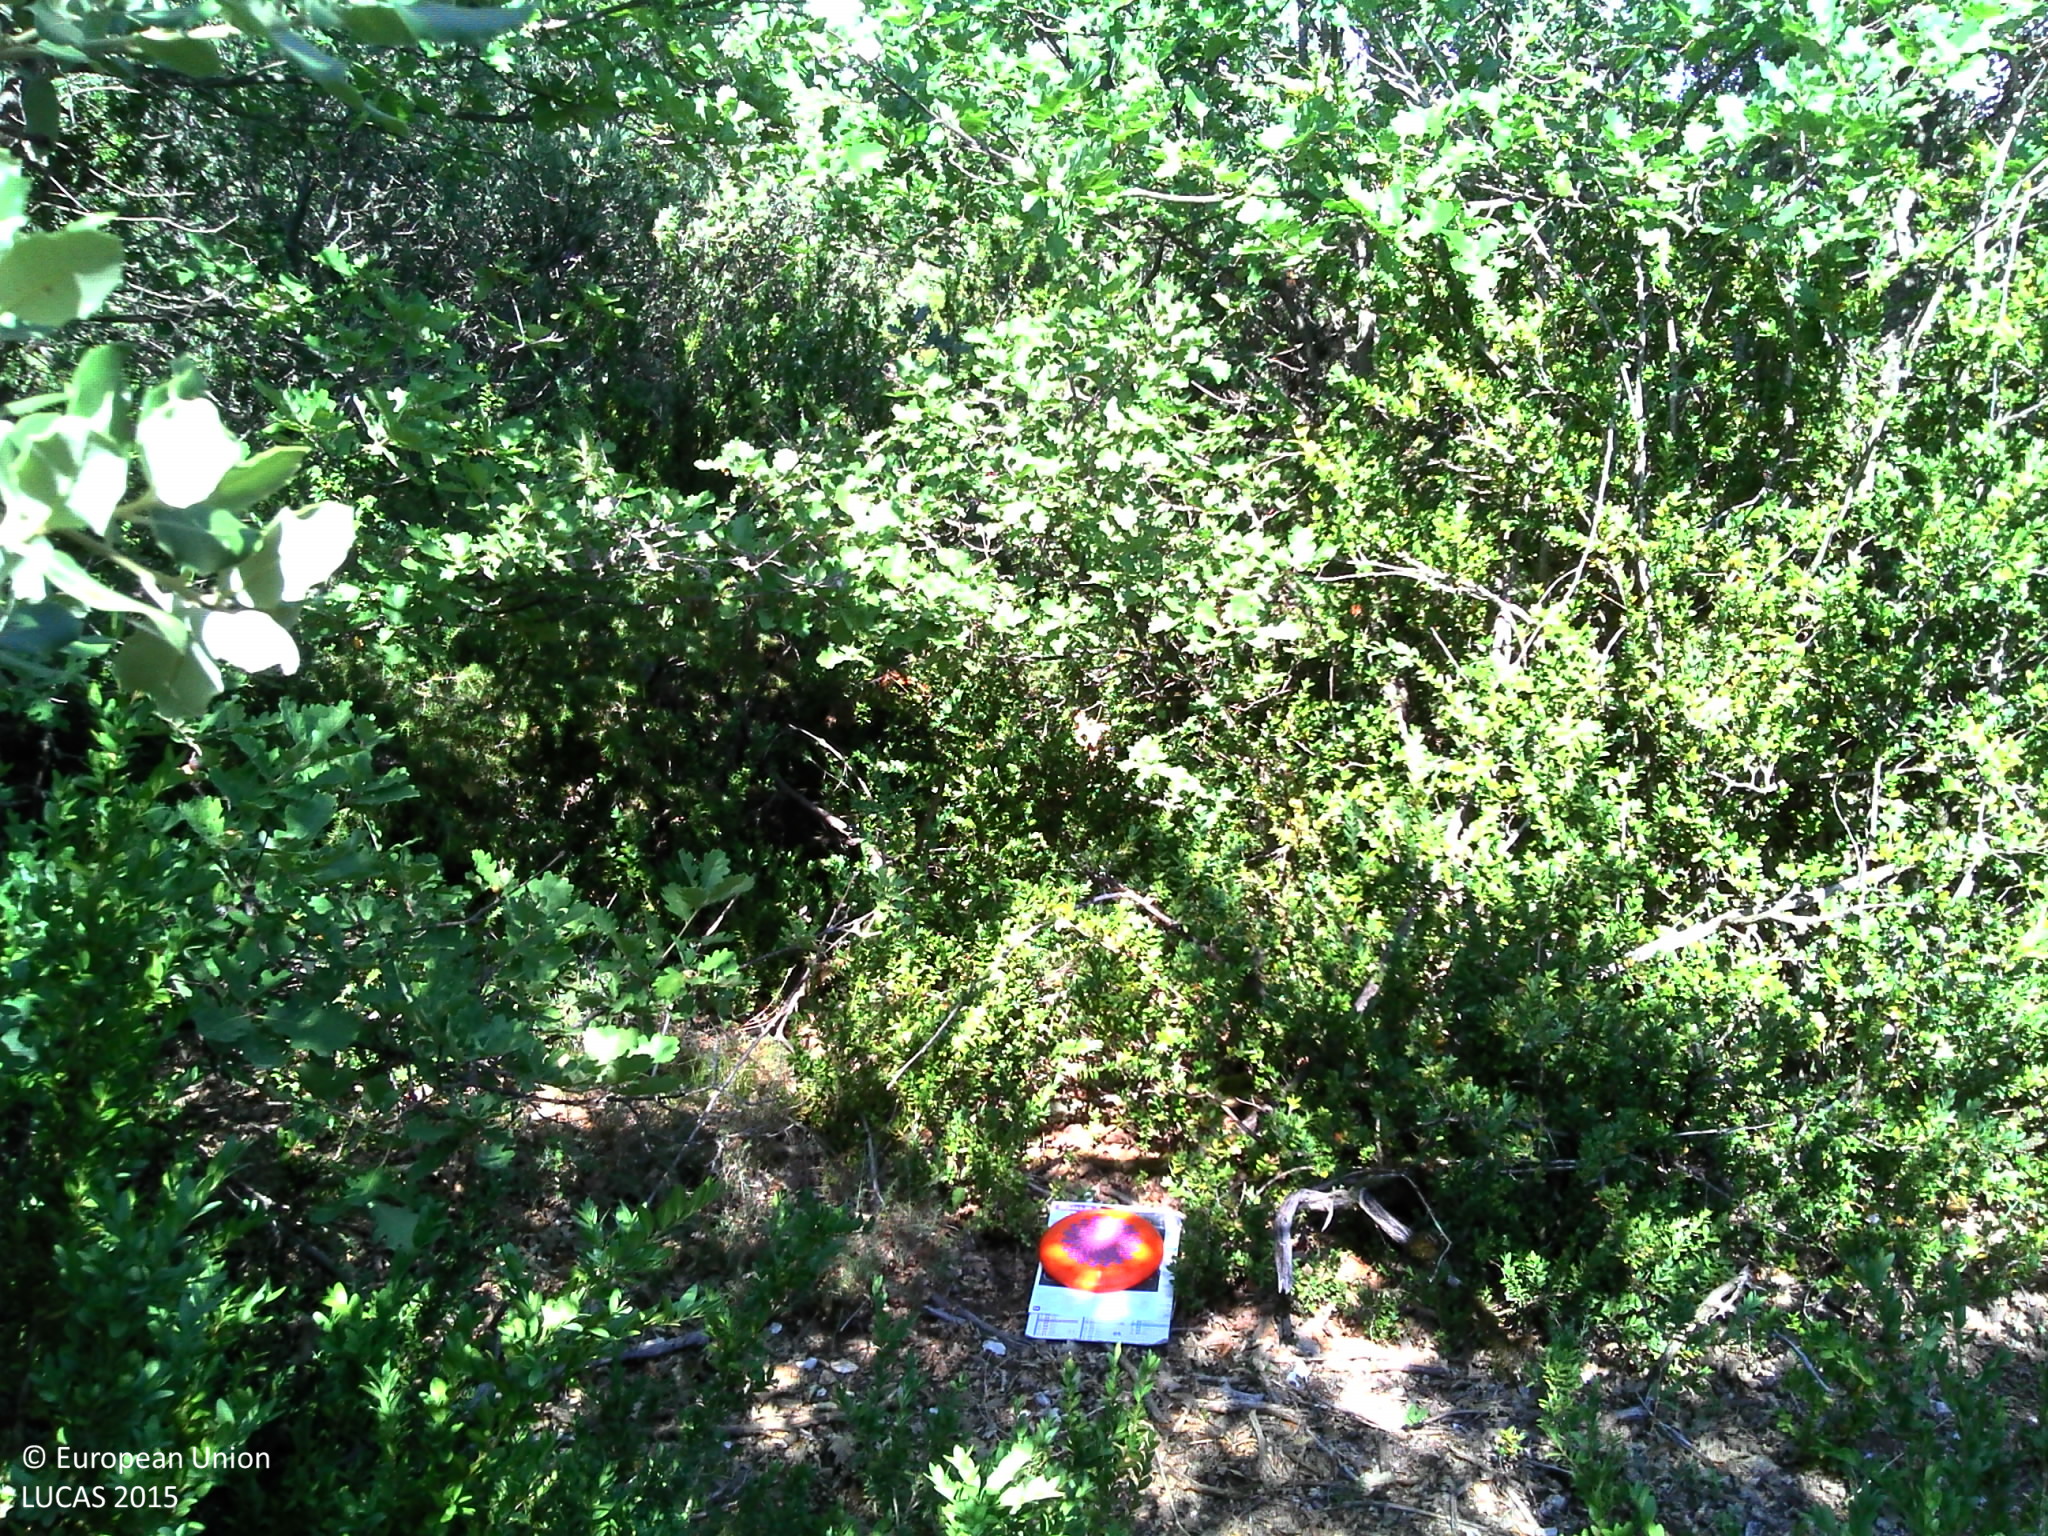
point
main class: Woodland
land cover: Broadleaved woodland
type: broadleaved evergreen forest
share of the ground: > 75 %
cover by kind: broadleaved forest trees 70 %, shrubs 15 %, coniferous forest trees 5 %, herbaceous plants 5 %, unconsolidated bare surface 5 %
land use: Forestry
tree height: < 5 m
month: July
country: FR
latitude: 43.9498
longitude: 5.1864
